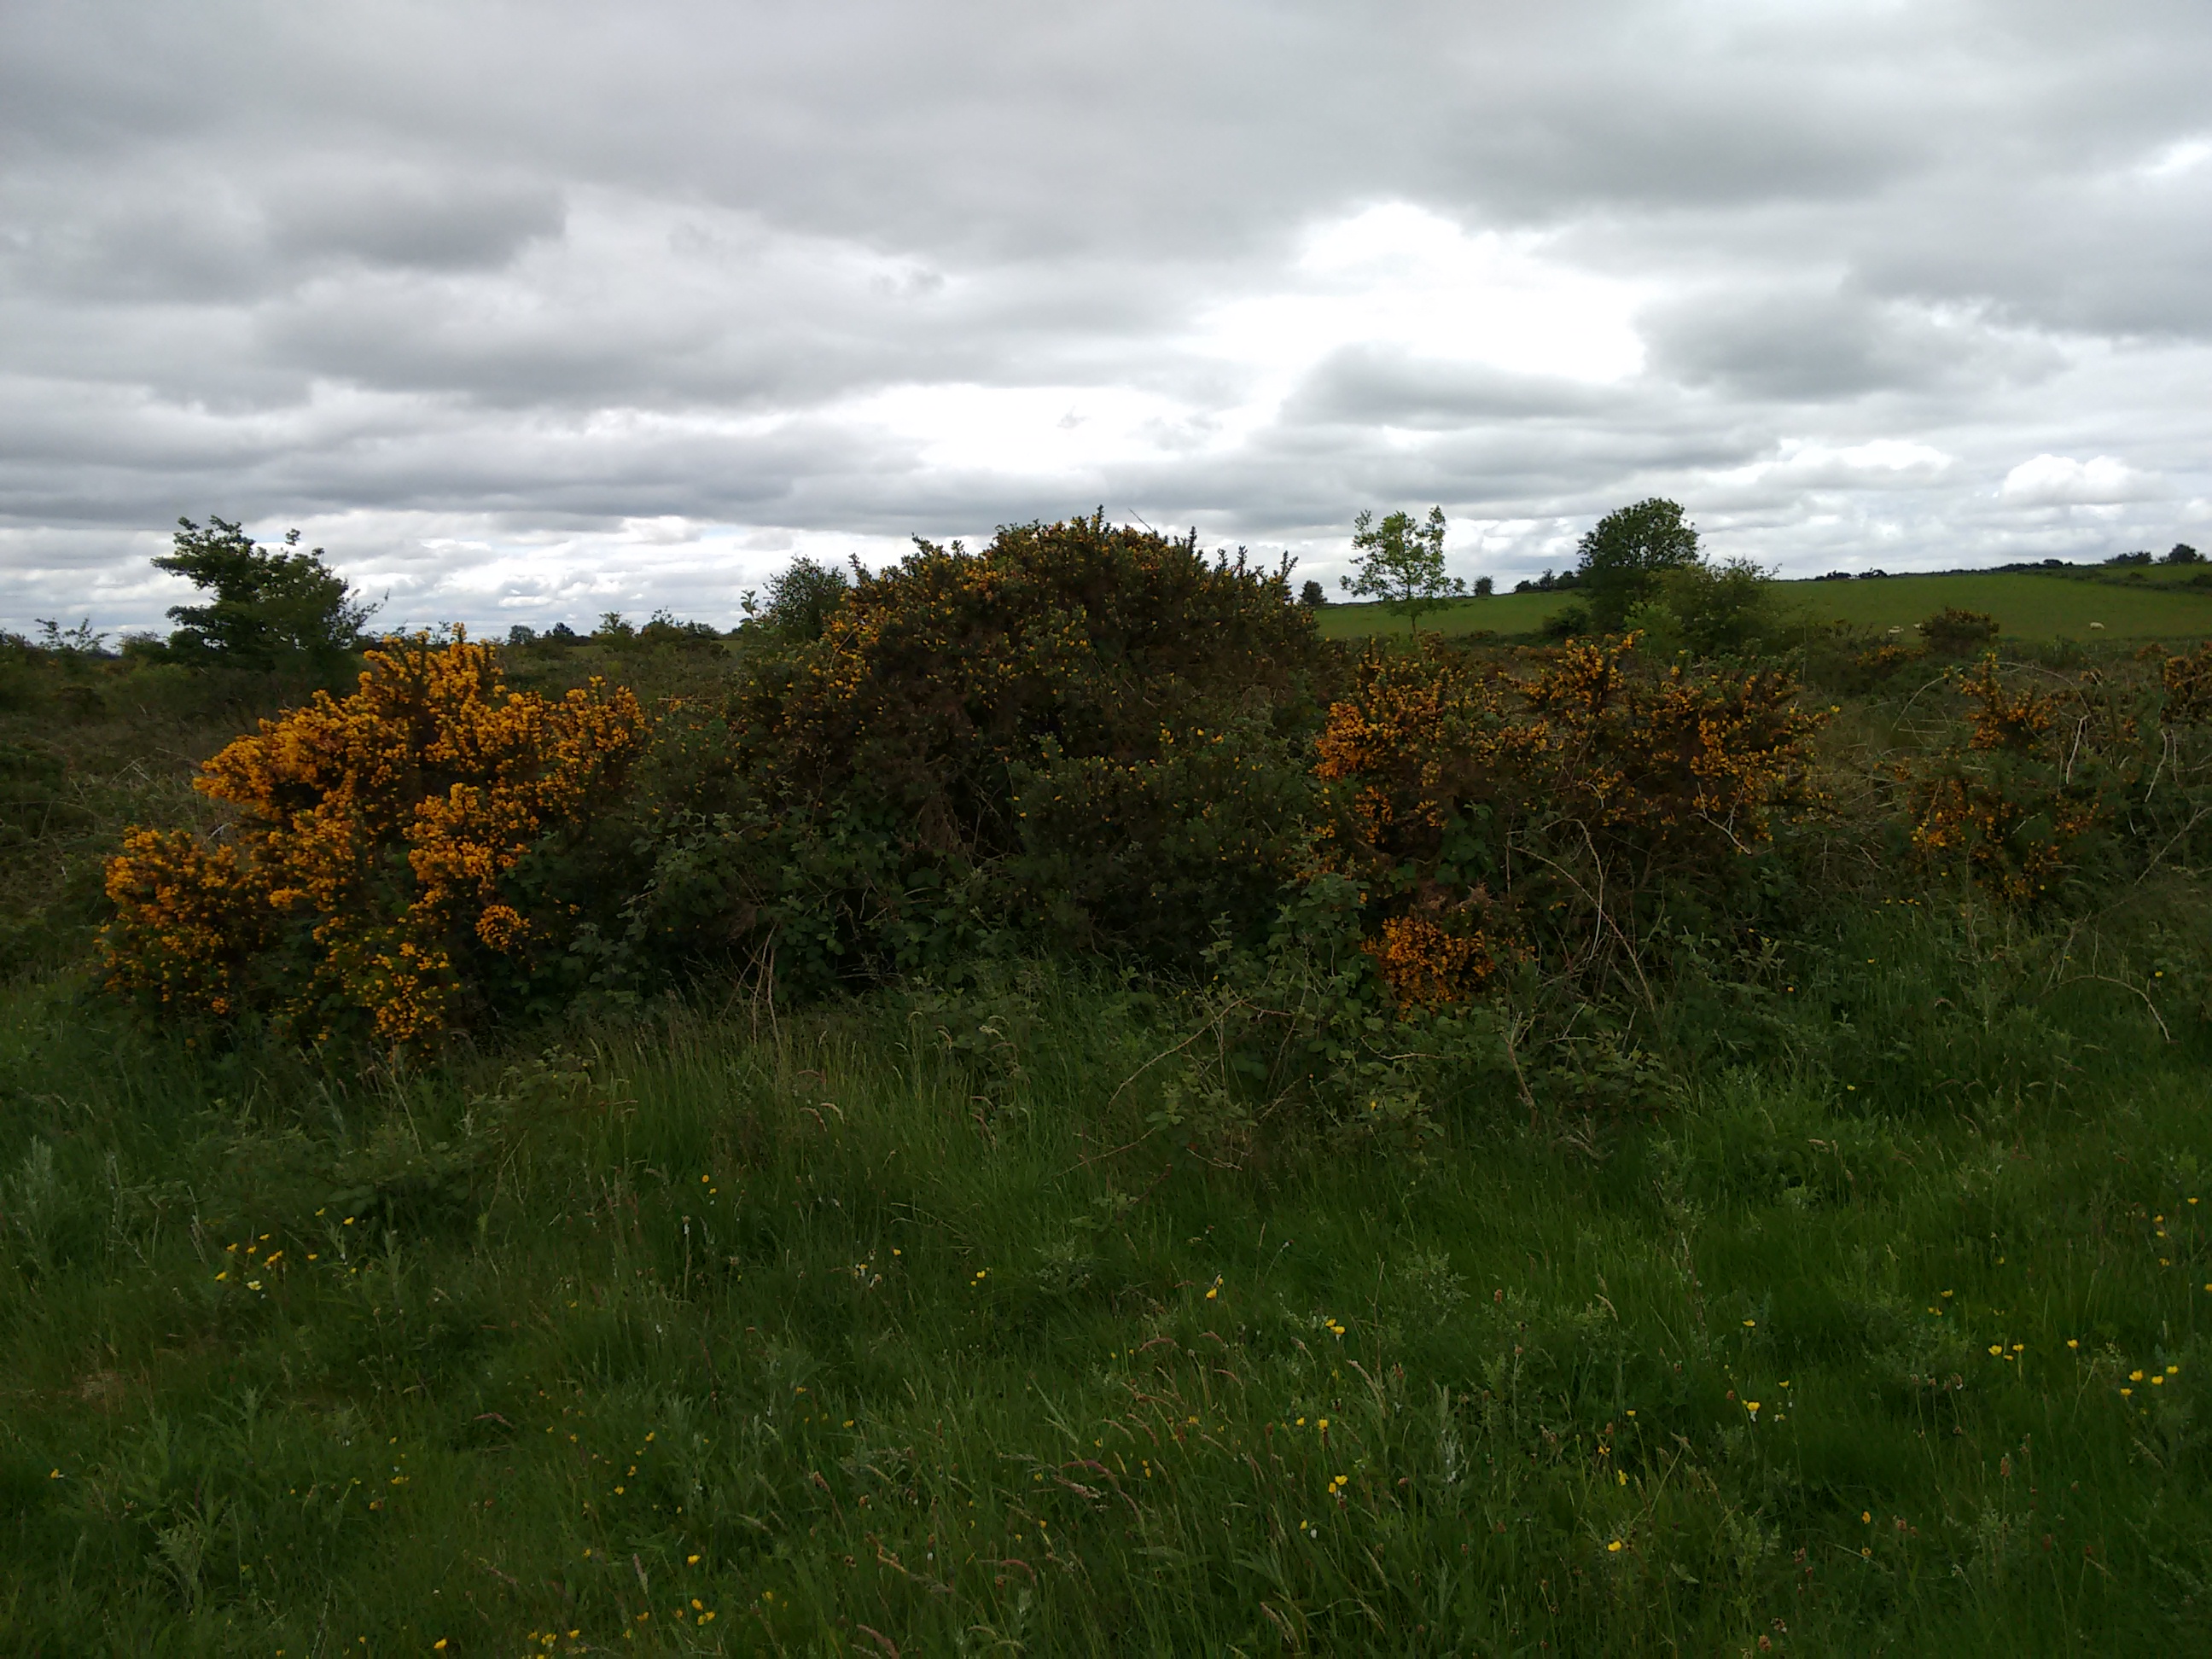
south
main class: Shrubland
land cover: Shrubland without tree cover
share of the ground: > 75 %
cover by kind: herbaceous plants 60 %, shrubs 40 %
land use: Agriculture (excluding fallow land and kitchen gardens)
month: June
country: IE
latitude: 53.5703
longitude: -8.8243
